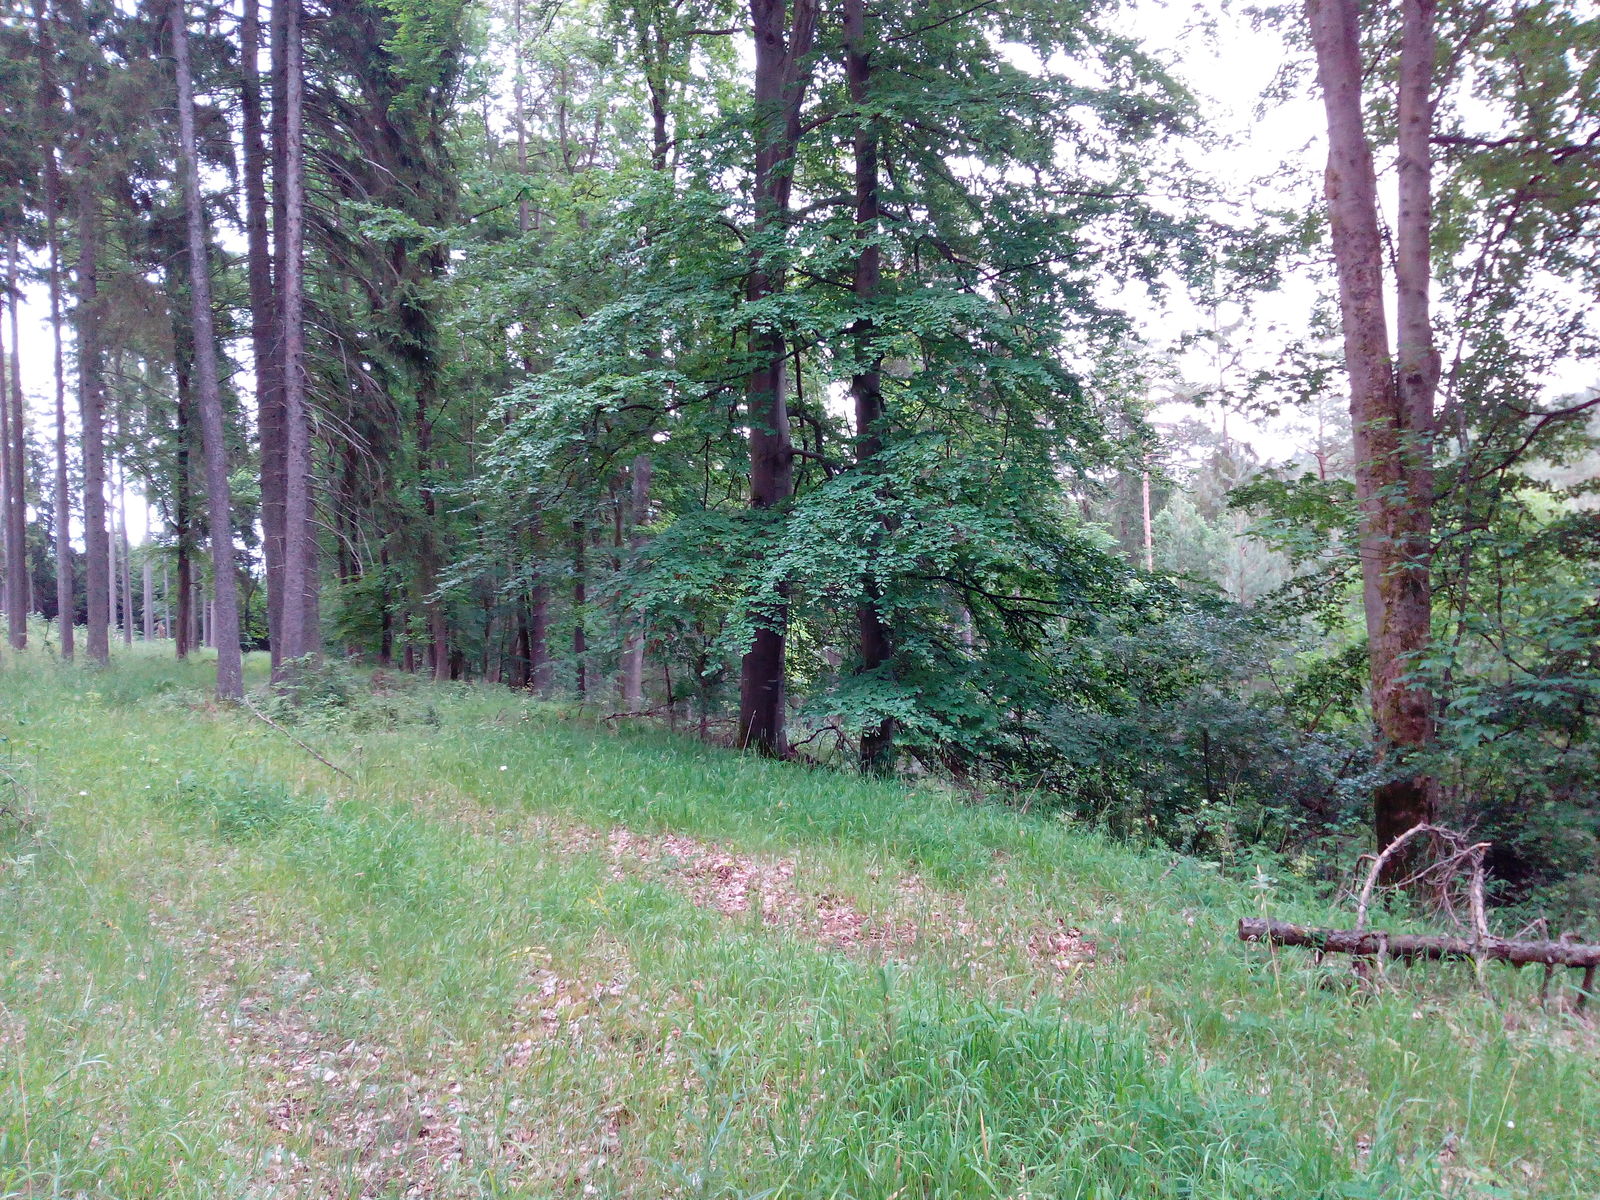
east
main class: Woodland
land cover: Spruce dominated coniferous woodland
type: hemiboreal forest and nemoral coniferous forest and mixed broadleaved-coniferous forest
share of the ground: 50 - 75 %
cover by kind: coniferous forest trees 60 %, herbaceous plants 30 %, shrubs 10 %
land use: Forestry
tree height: > 5 m
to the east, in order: Spruce dominated coniferous woodland; Other mixed woodland; Pine dominated coniferous woodland; Spruce dominated coniferous woodland; Ditches and canals; Grass margins; Tracks
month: June
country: DE
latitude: 50.4522
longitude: 10.6336
